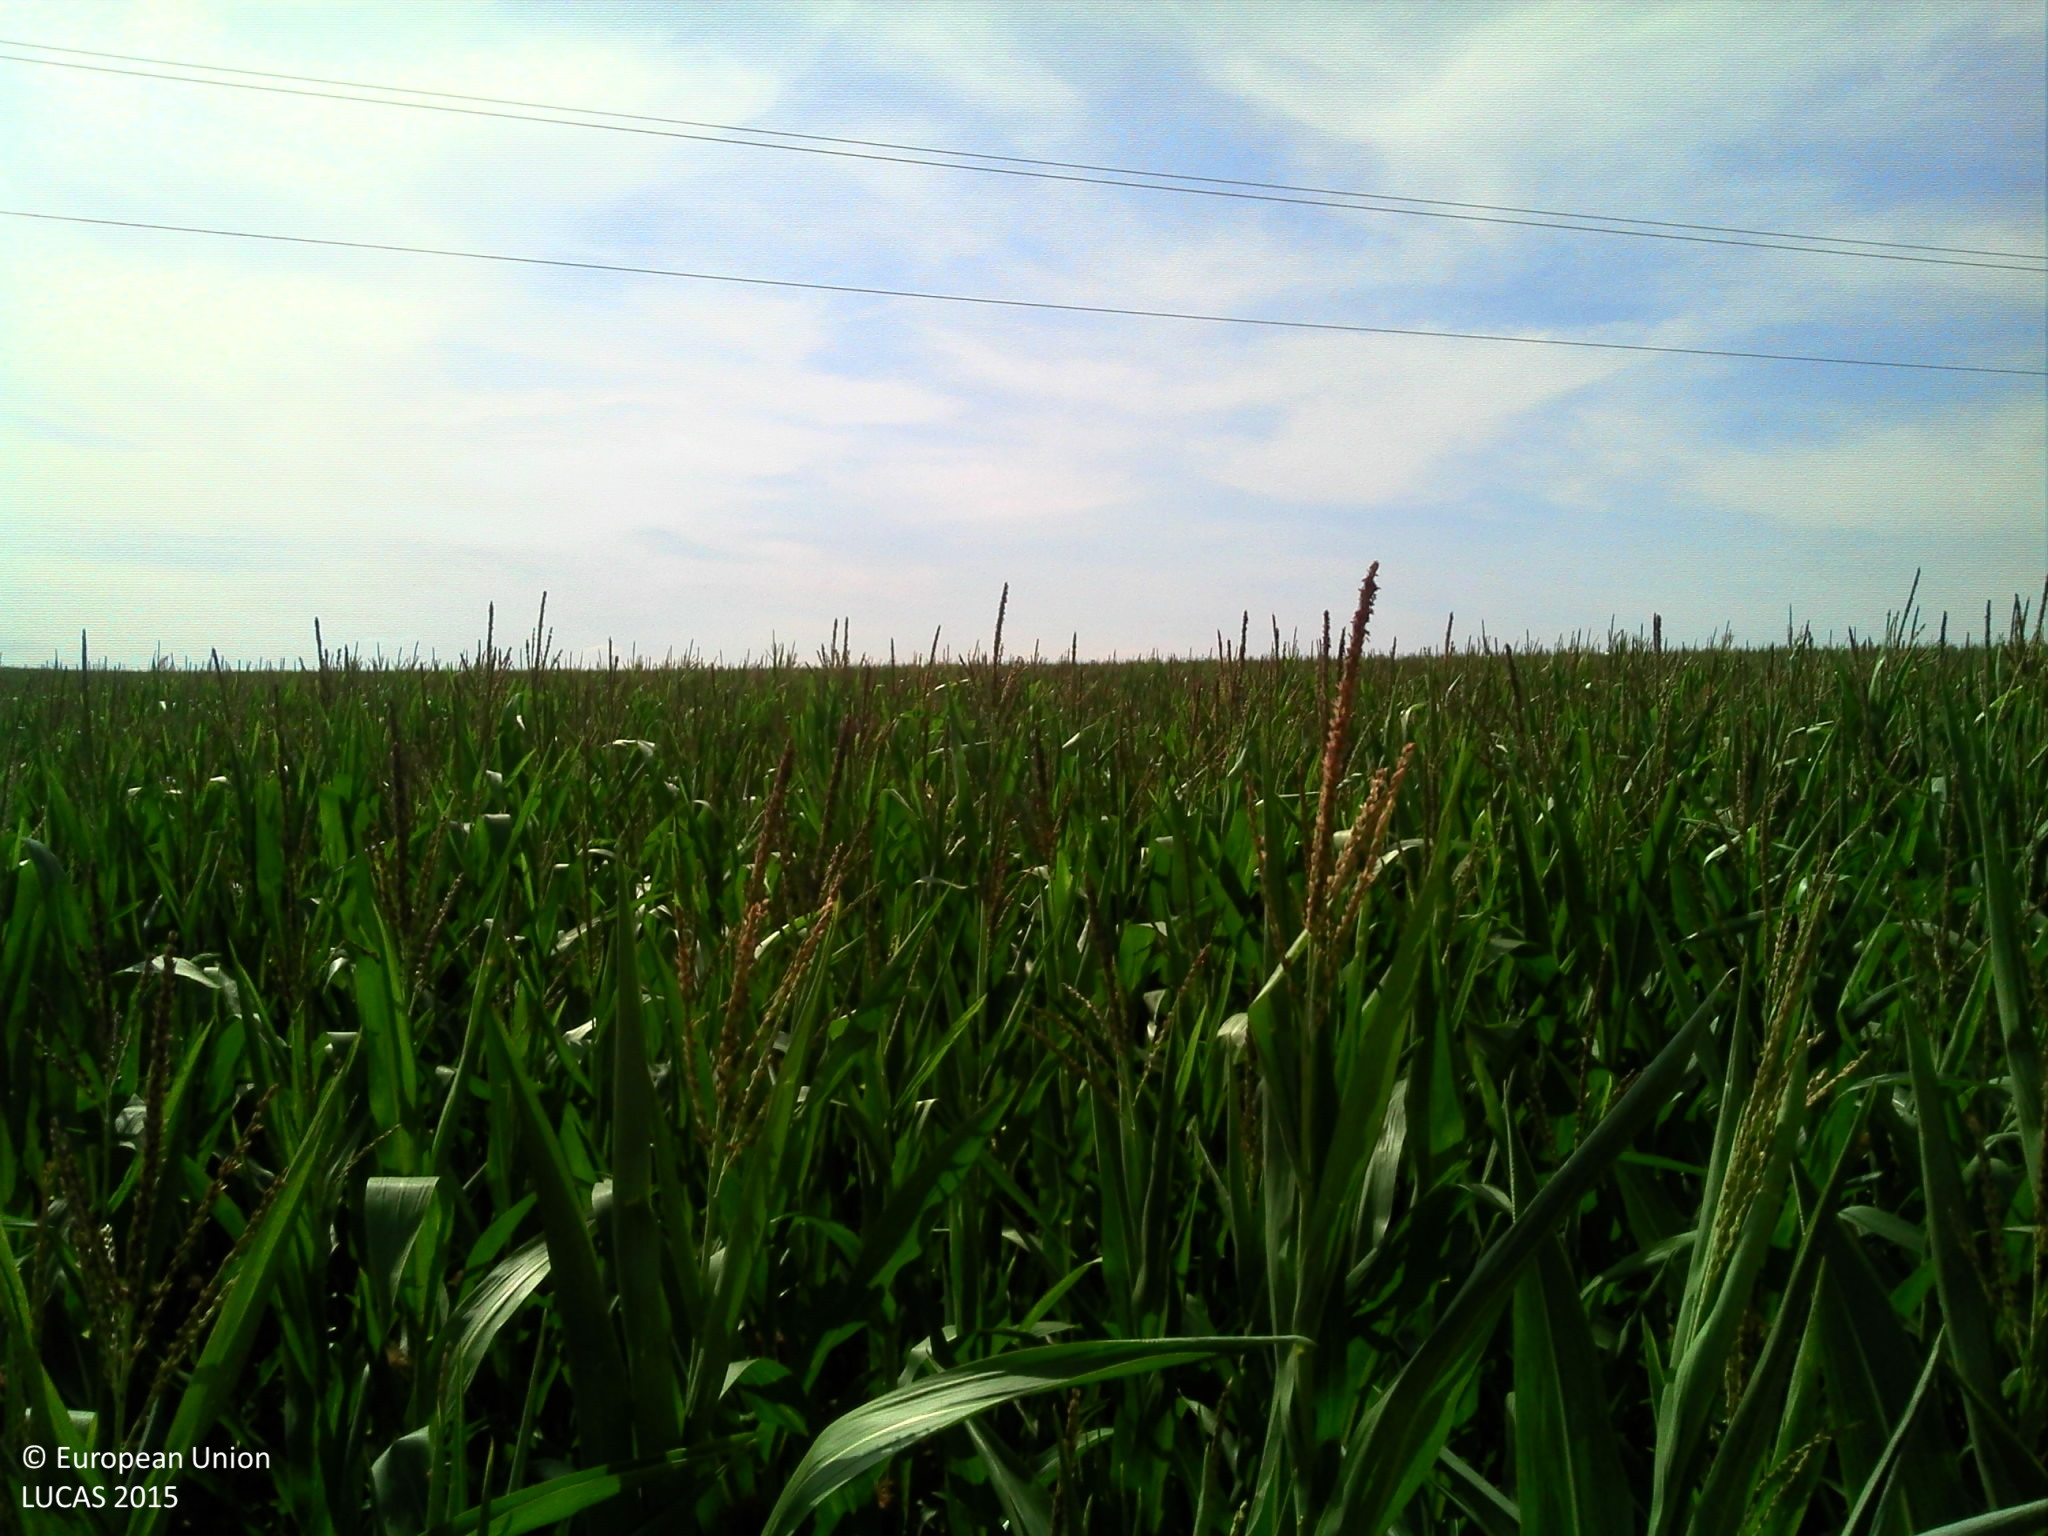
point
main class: Cropland
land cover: Maize
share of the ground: > 75 %
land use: Agriculture (excluding fallow land and kitchen gardens)
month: August
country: FR
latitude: 48.6532
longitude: 3.3279
